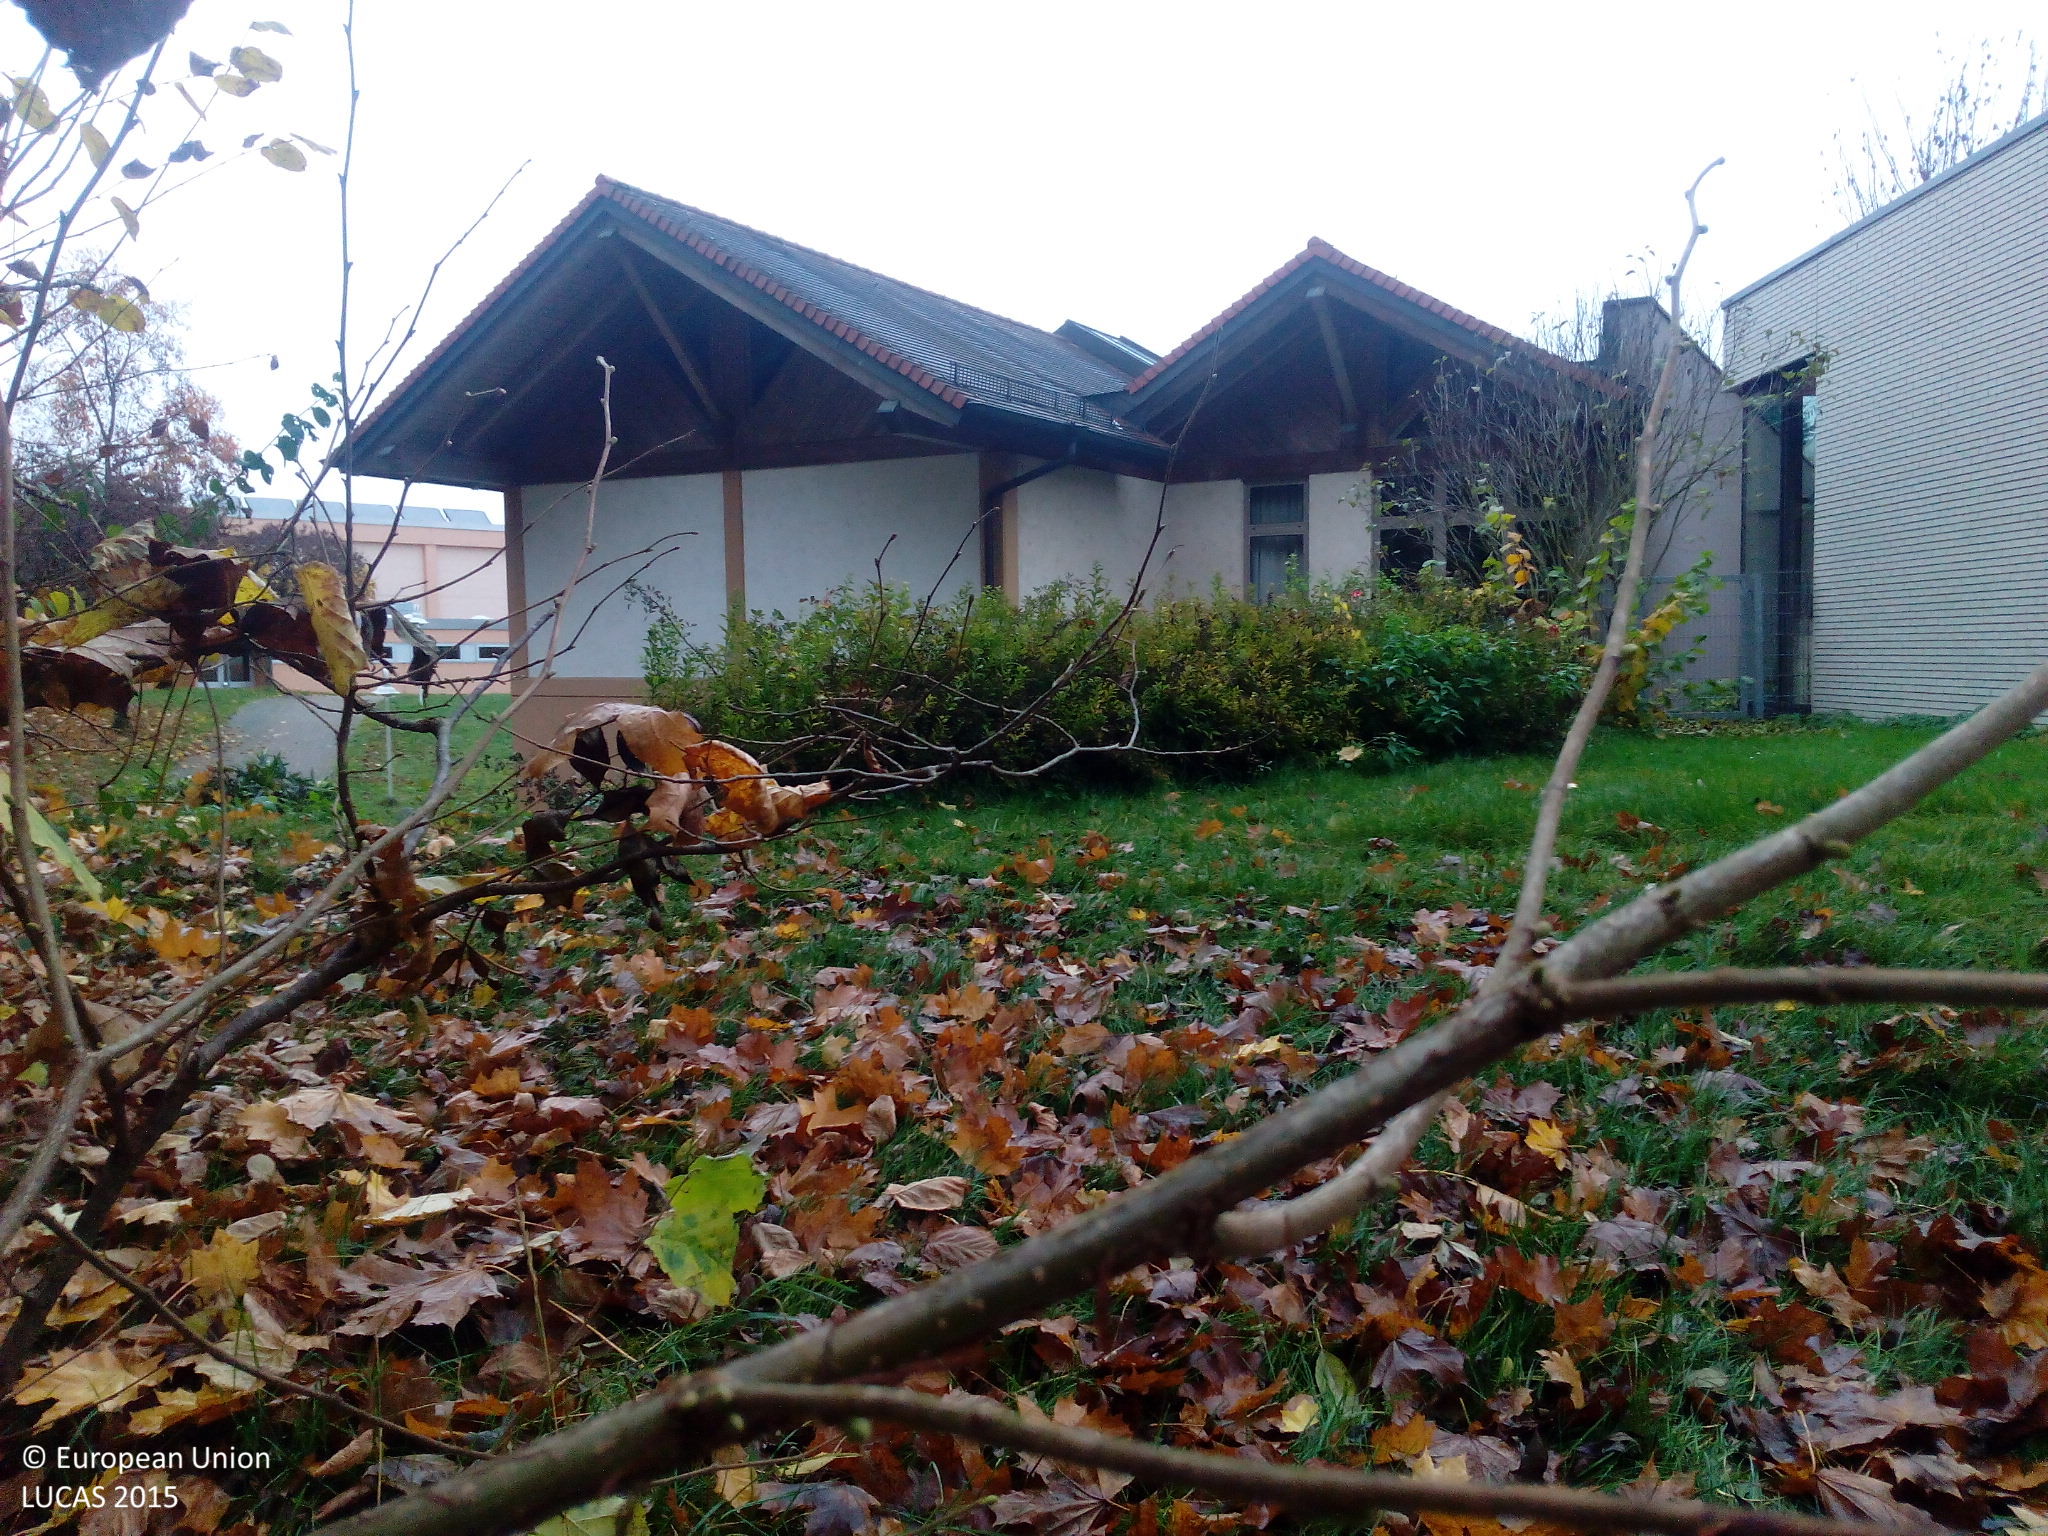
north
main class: Woodland
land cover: Broadleaved woodland
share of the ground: > 75 %
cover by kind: broadleaved forest trees 85 %, herbaceous plants 10 %, shrubs 5 %
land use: Community services
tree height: > 5 m
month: May
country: DE
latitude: 49.0842
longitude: 9.1925
